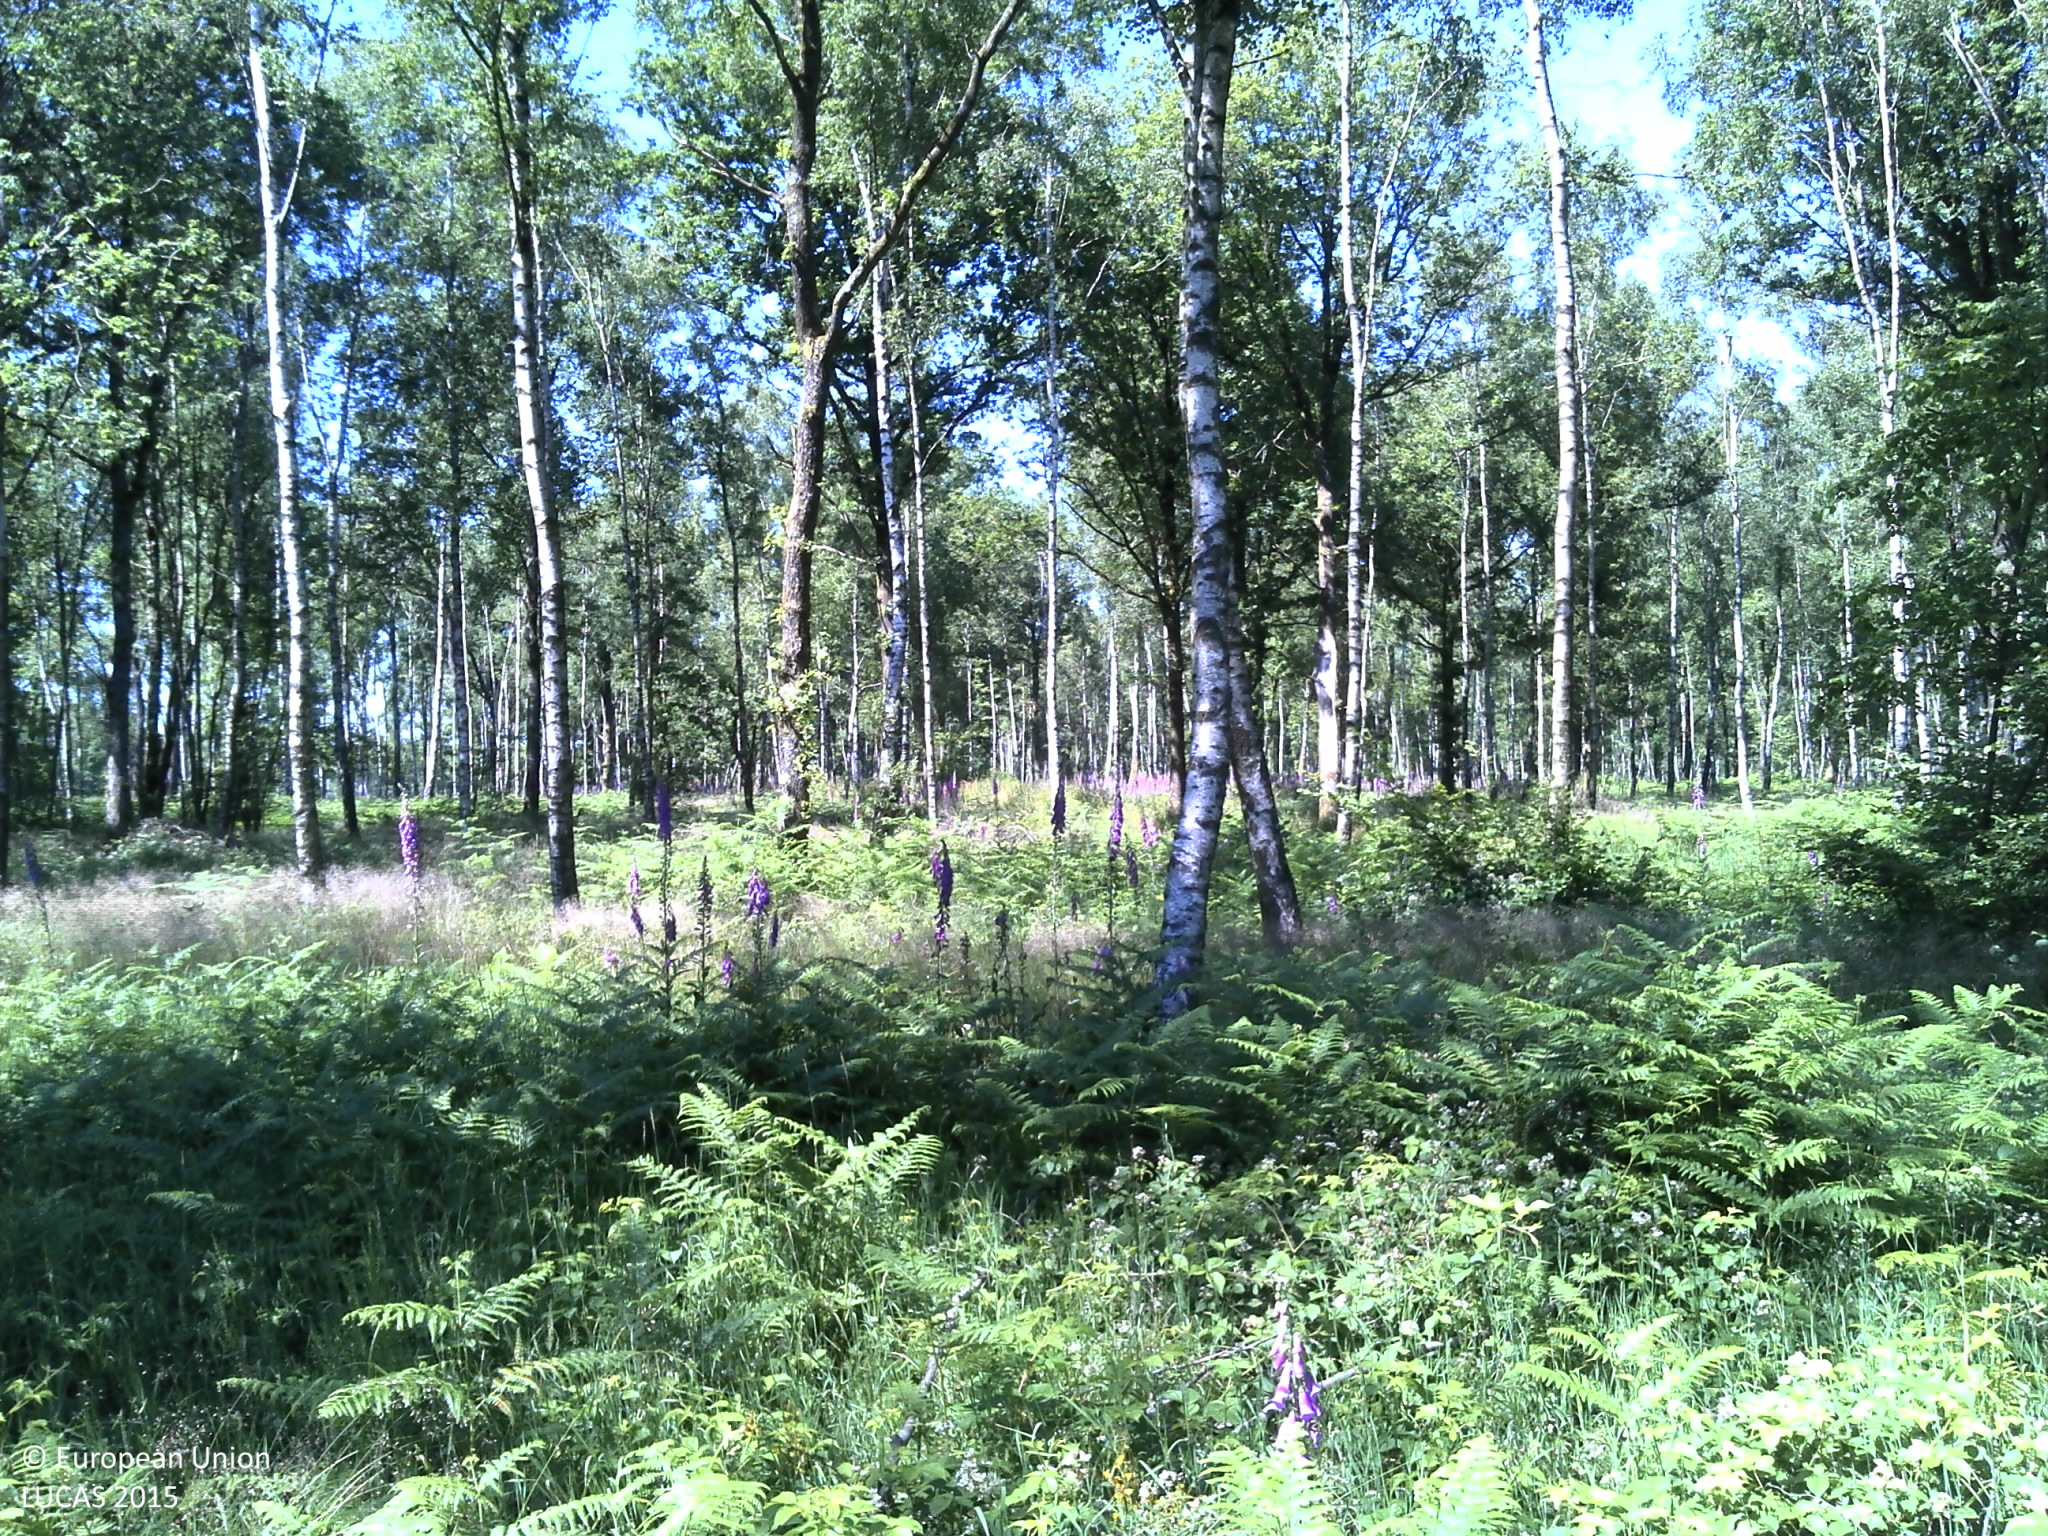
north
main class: Woodland
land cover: Broadleaved woodland
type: acidophilous oak and oak-birch forest
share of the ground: 25 - 50 %
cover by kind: broadleaved forest trees 50 %, herbaceous plants 40 %, lichens and mosses 5 %, consolidated bare surface 5 %
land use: Forestry
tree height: > 5 m
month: June
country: FR
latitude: 50.0099
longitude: 4.7640
